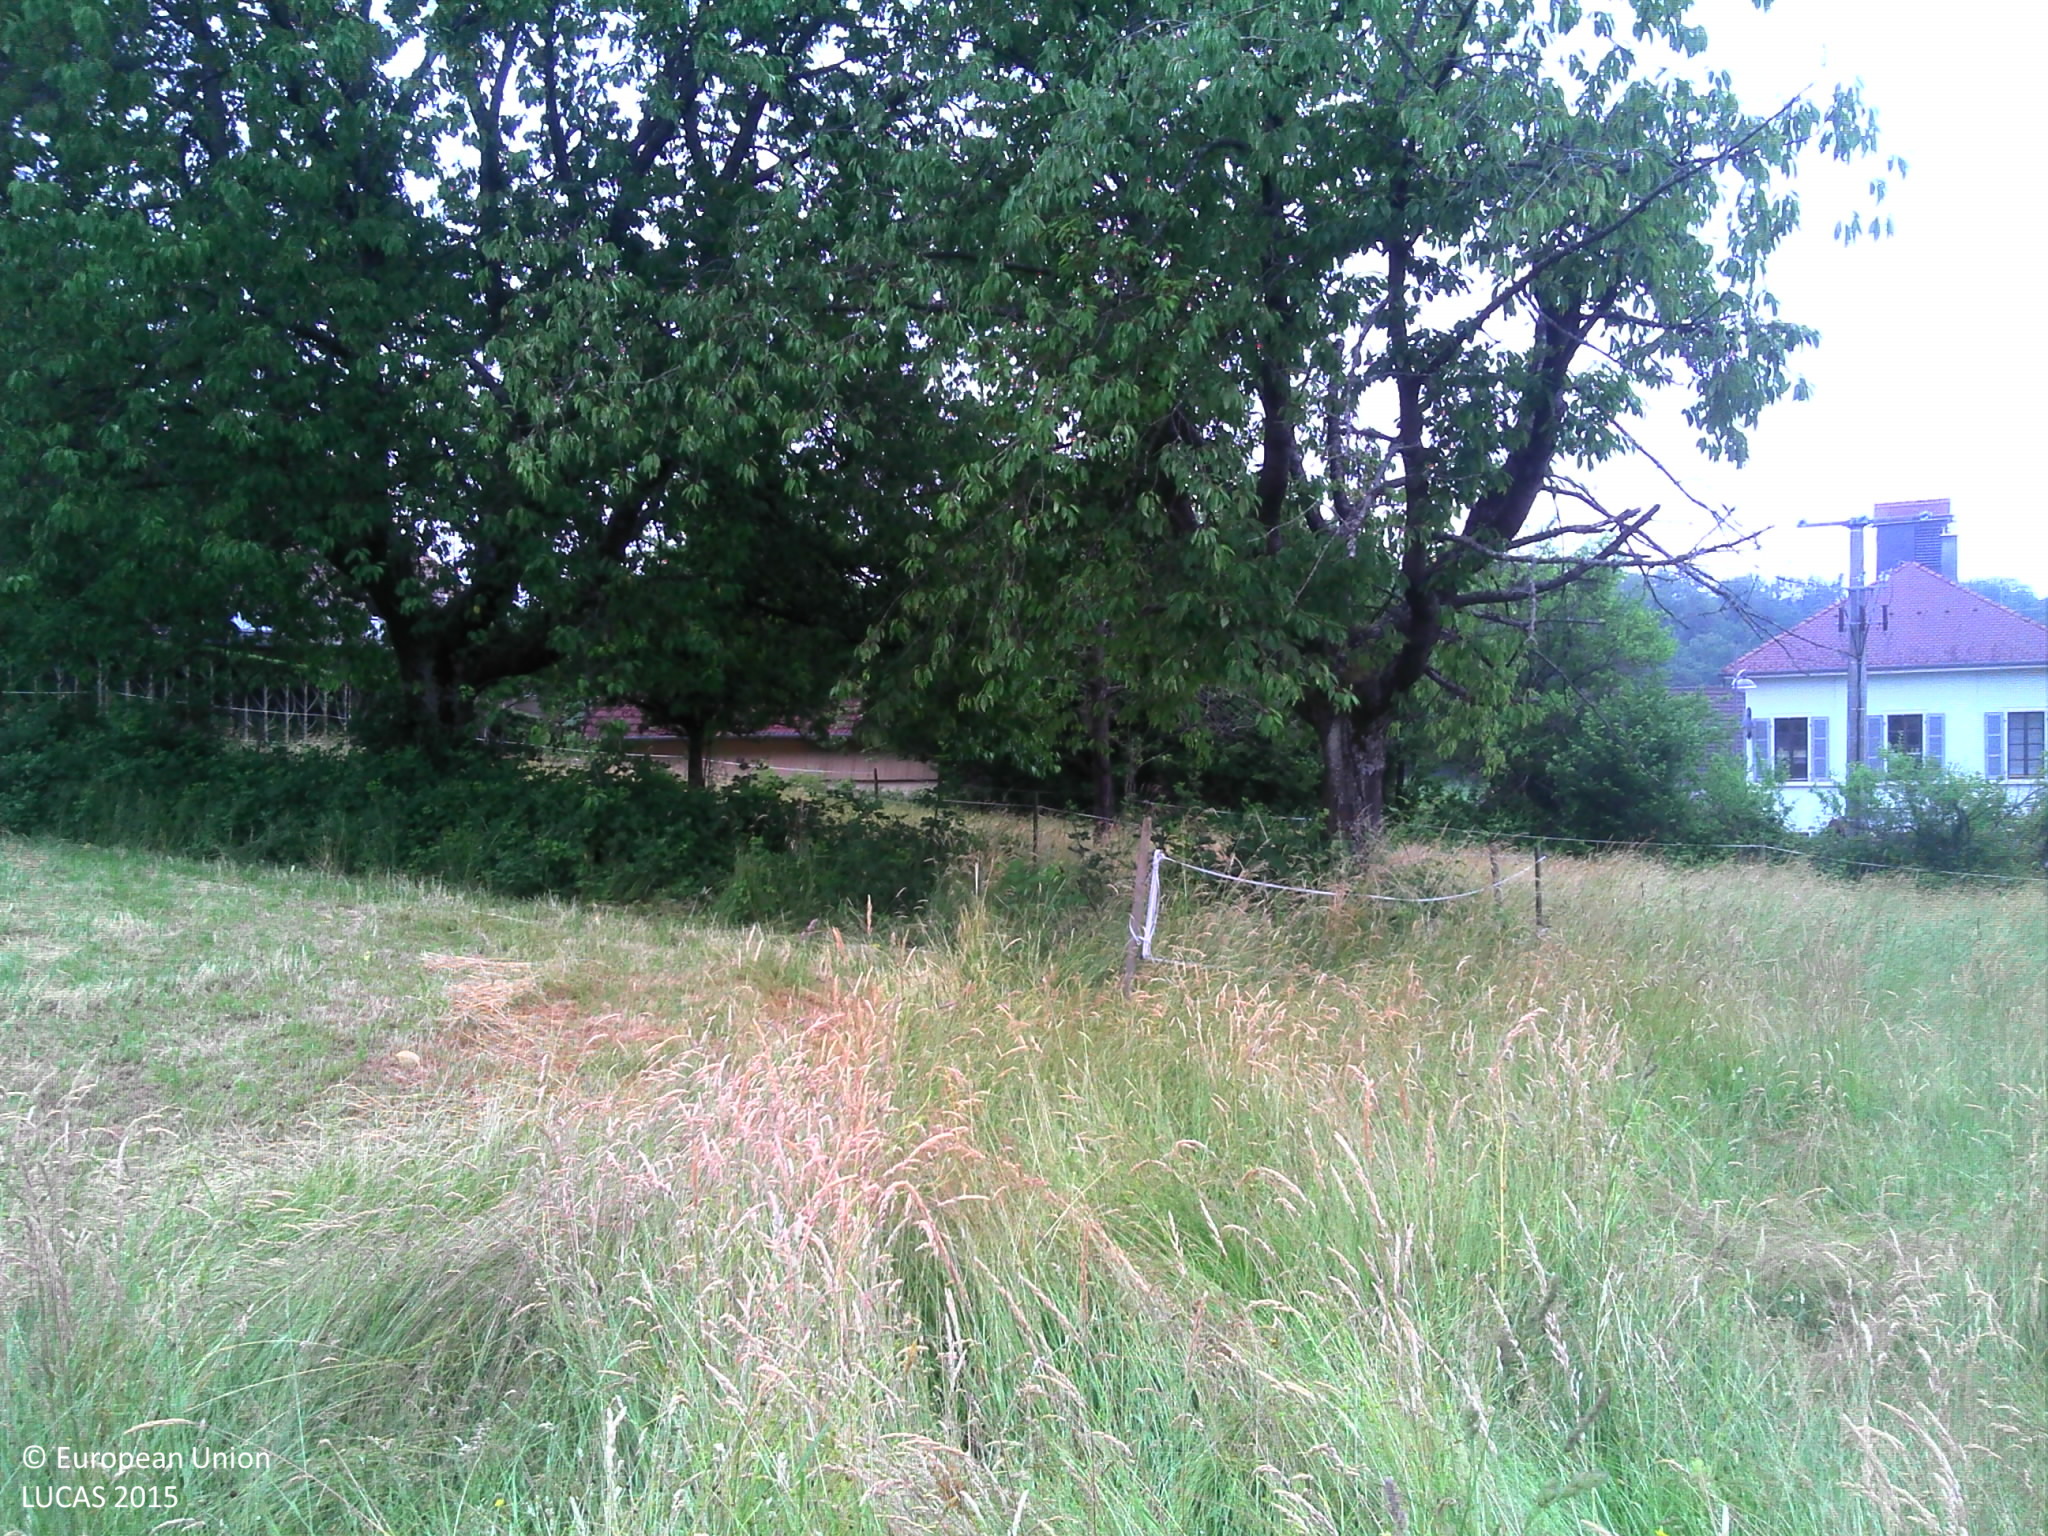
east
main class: Grassland
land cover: Grassland with sparse tree/shrub cover
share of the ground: > 75 %
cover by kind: herbaceous plants 95 %, broadleaved forest trees 5 %
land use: Agriculture (excluding fallow land and kitchen gardens)
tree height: > 5 m
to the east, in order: Grassland with sparse tree/shrub cover; Broadleaved woodland; Grassland with sparse tree/shrub cover; Fences; Broadleaved woodland; Artificial constructions in urban areas
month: June
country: FR
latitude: 47.5089
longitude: 7.4126
